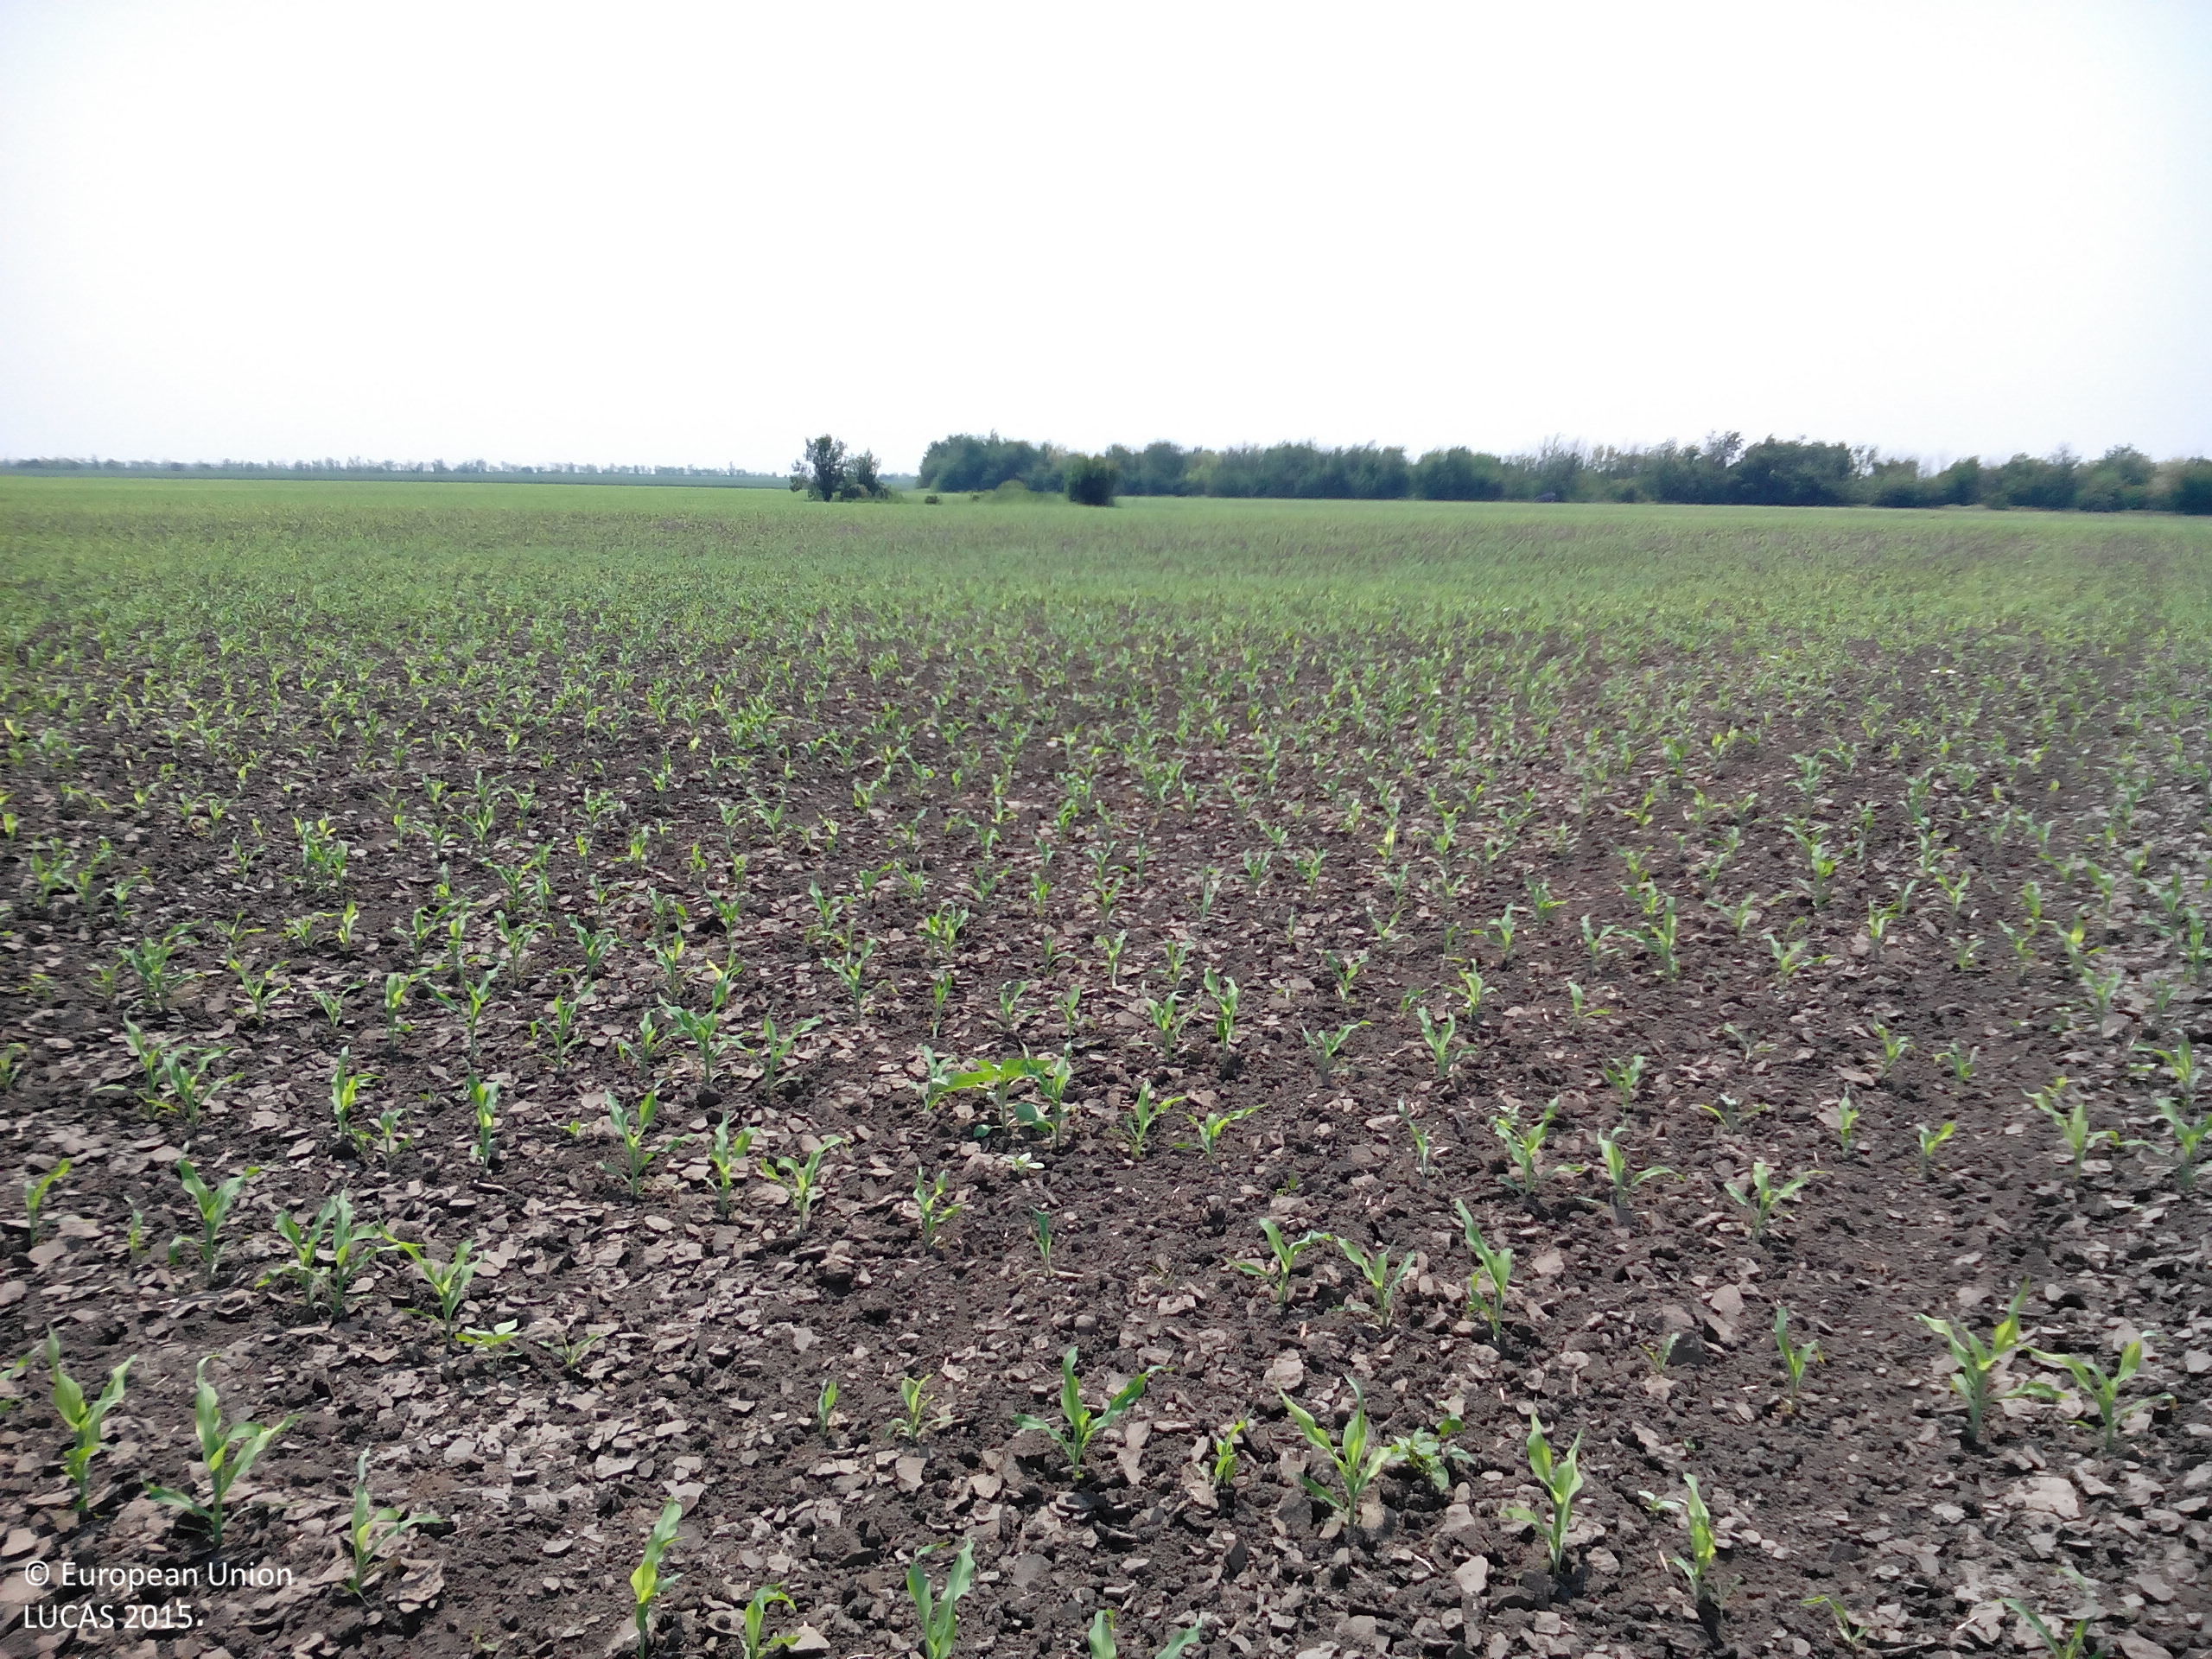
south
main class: Cropland
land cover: Maize
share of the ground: 10 - 25 %
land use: Agriculture (excluding fallow land and kitchen gardens)
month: May
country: BG
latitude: 43.6062
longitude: 24.0671
